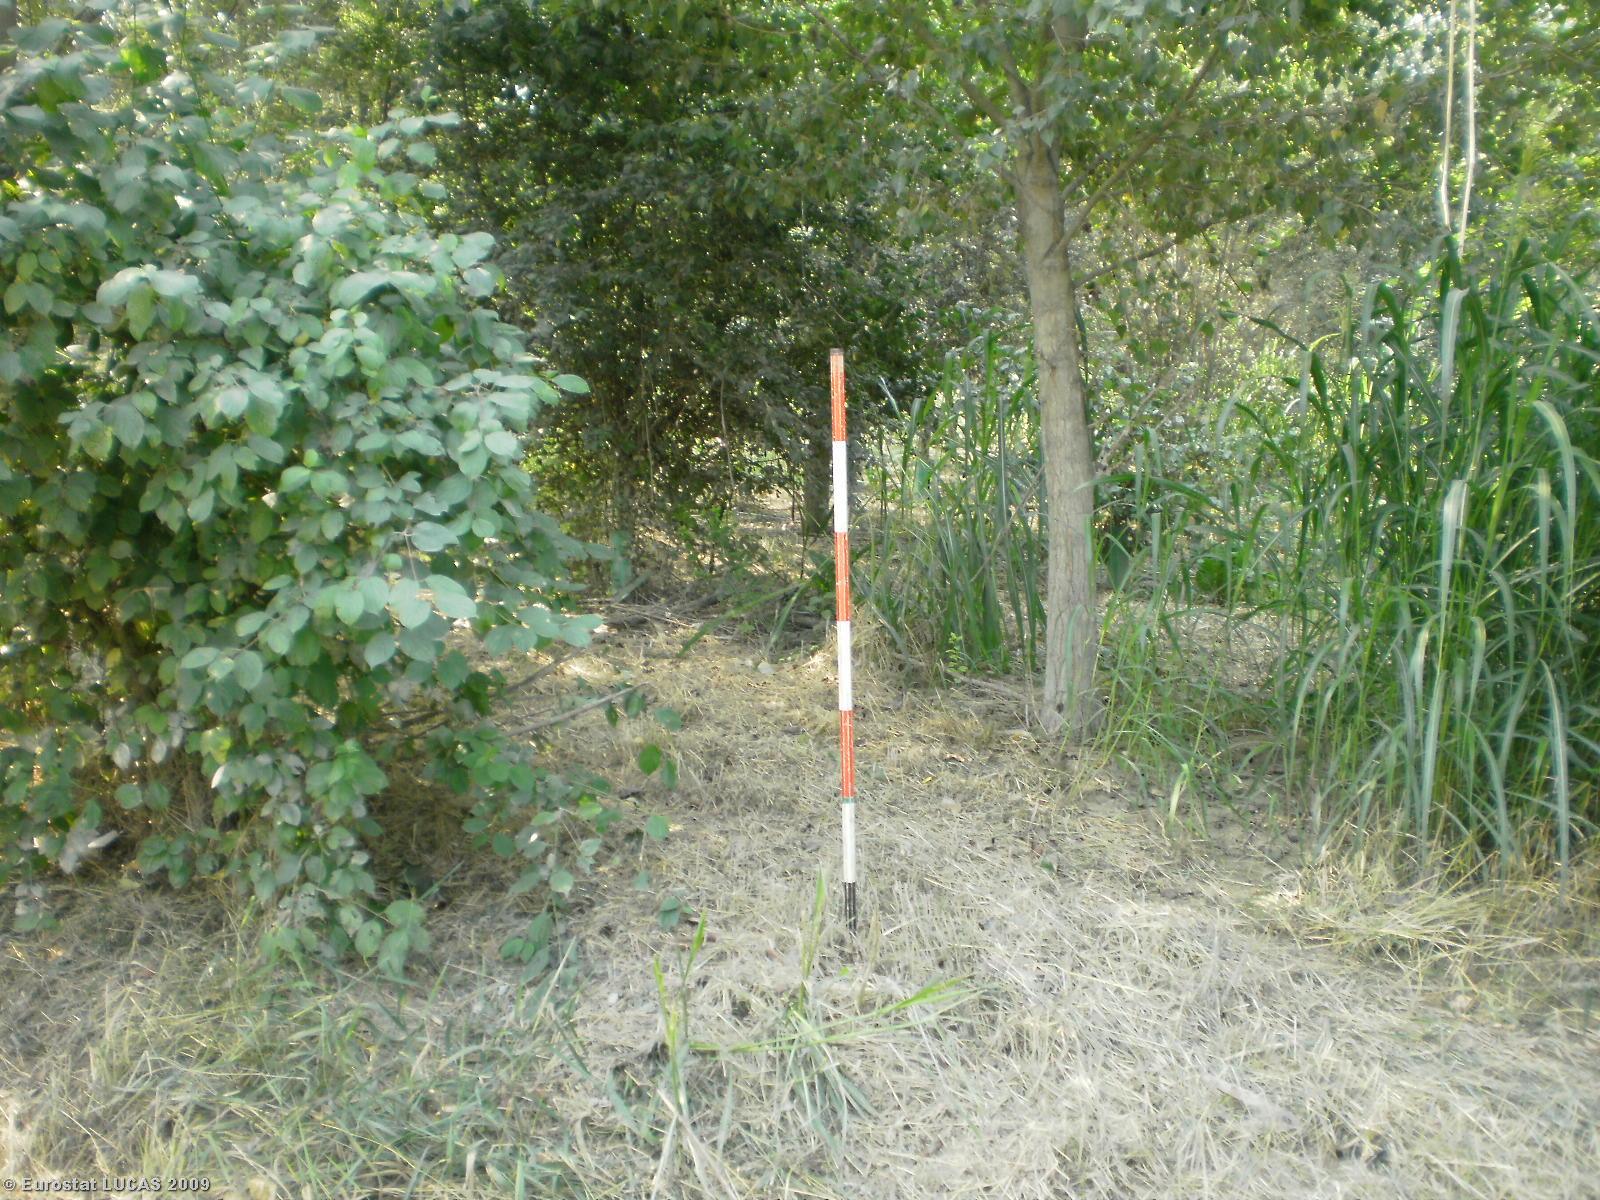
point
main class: Woodland
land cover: Broadleaved woodland
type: non-riverine alder, birch or aspen forest
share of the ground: > 75 %
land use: Forestry
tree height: > 5 m
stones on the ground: < 10 %
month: July
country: IT
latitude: 44.9447
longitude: 10.4427
